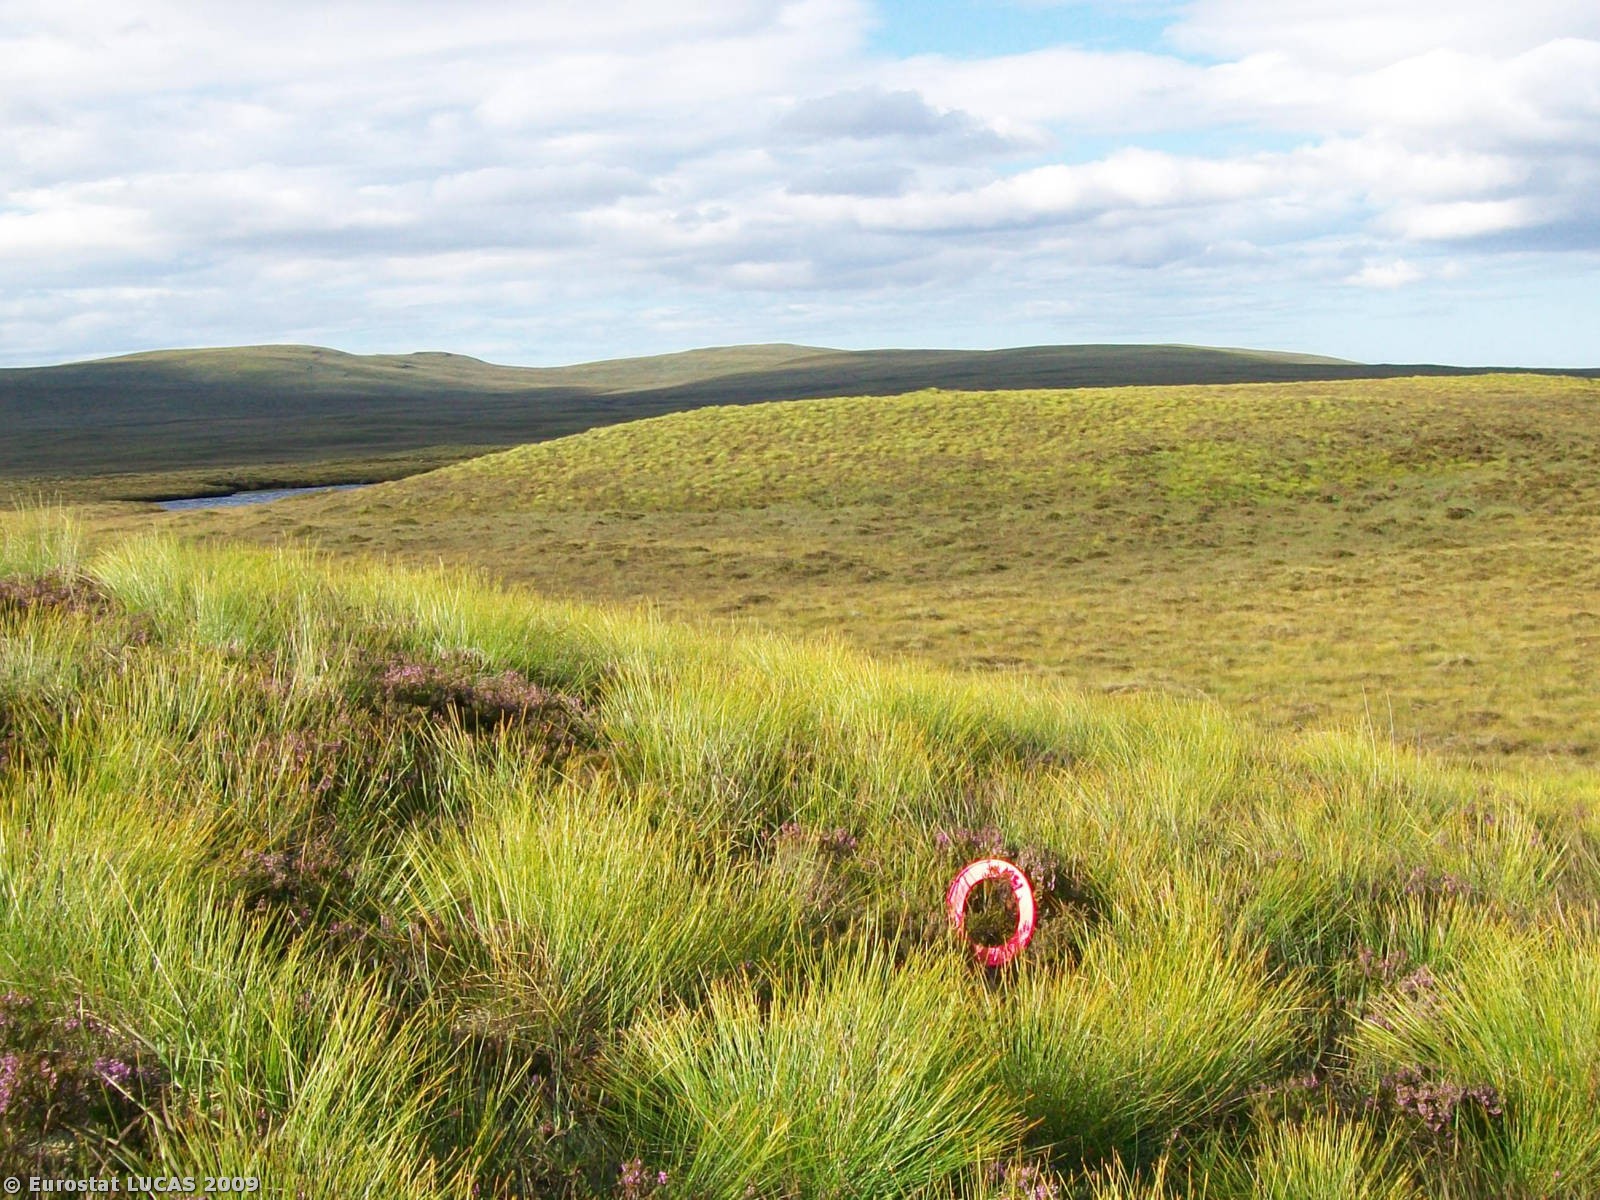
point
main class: Shrubland
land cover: Shrubland without tree cover
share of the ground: > 75 %
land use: Fallow land
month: August
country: GB
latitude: 58.1935
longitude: -4.5301
